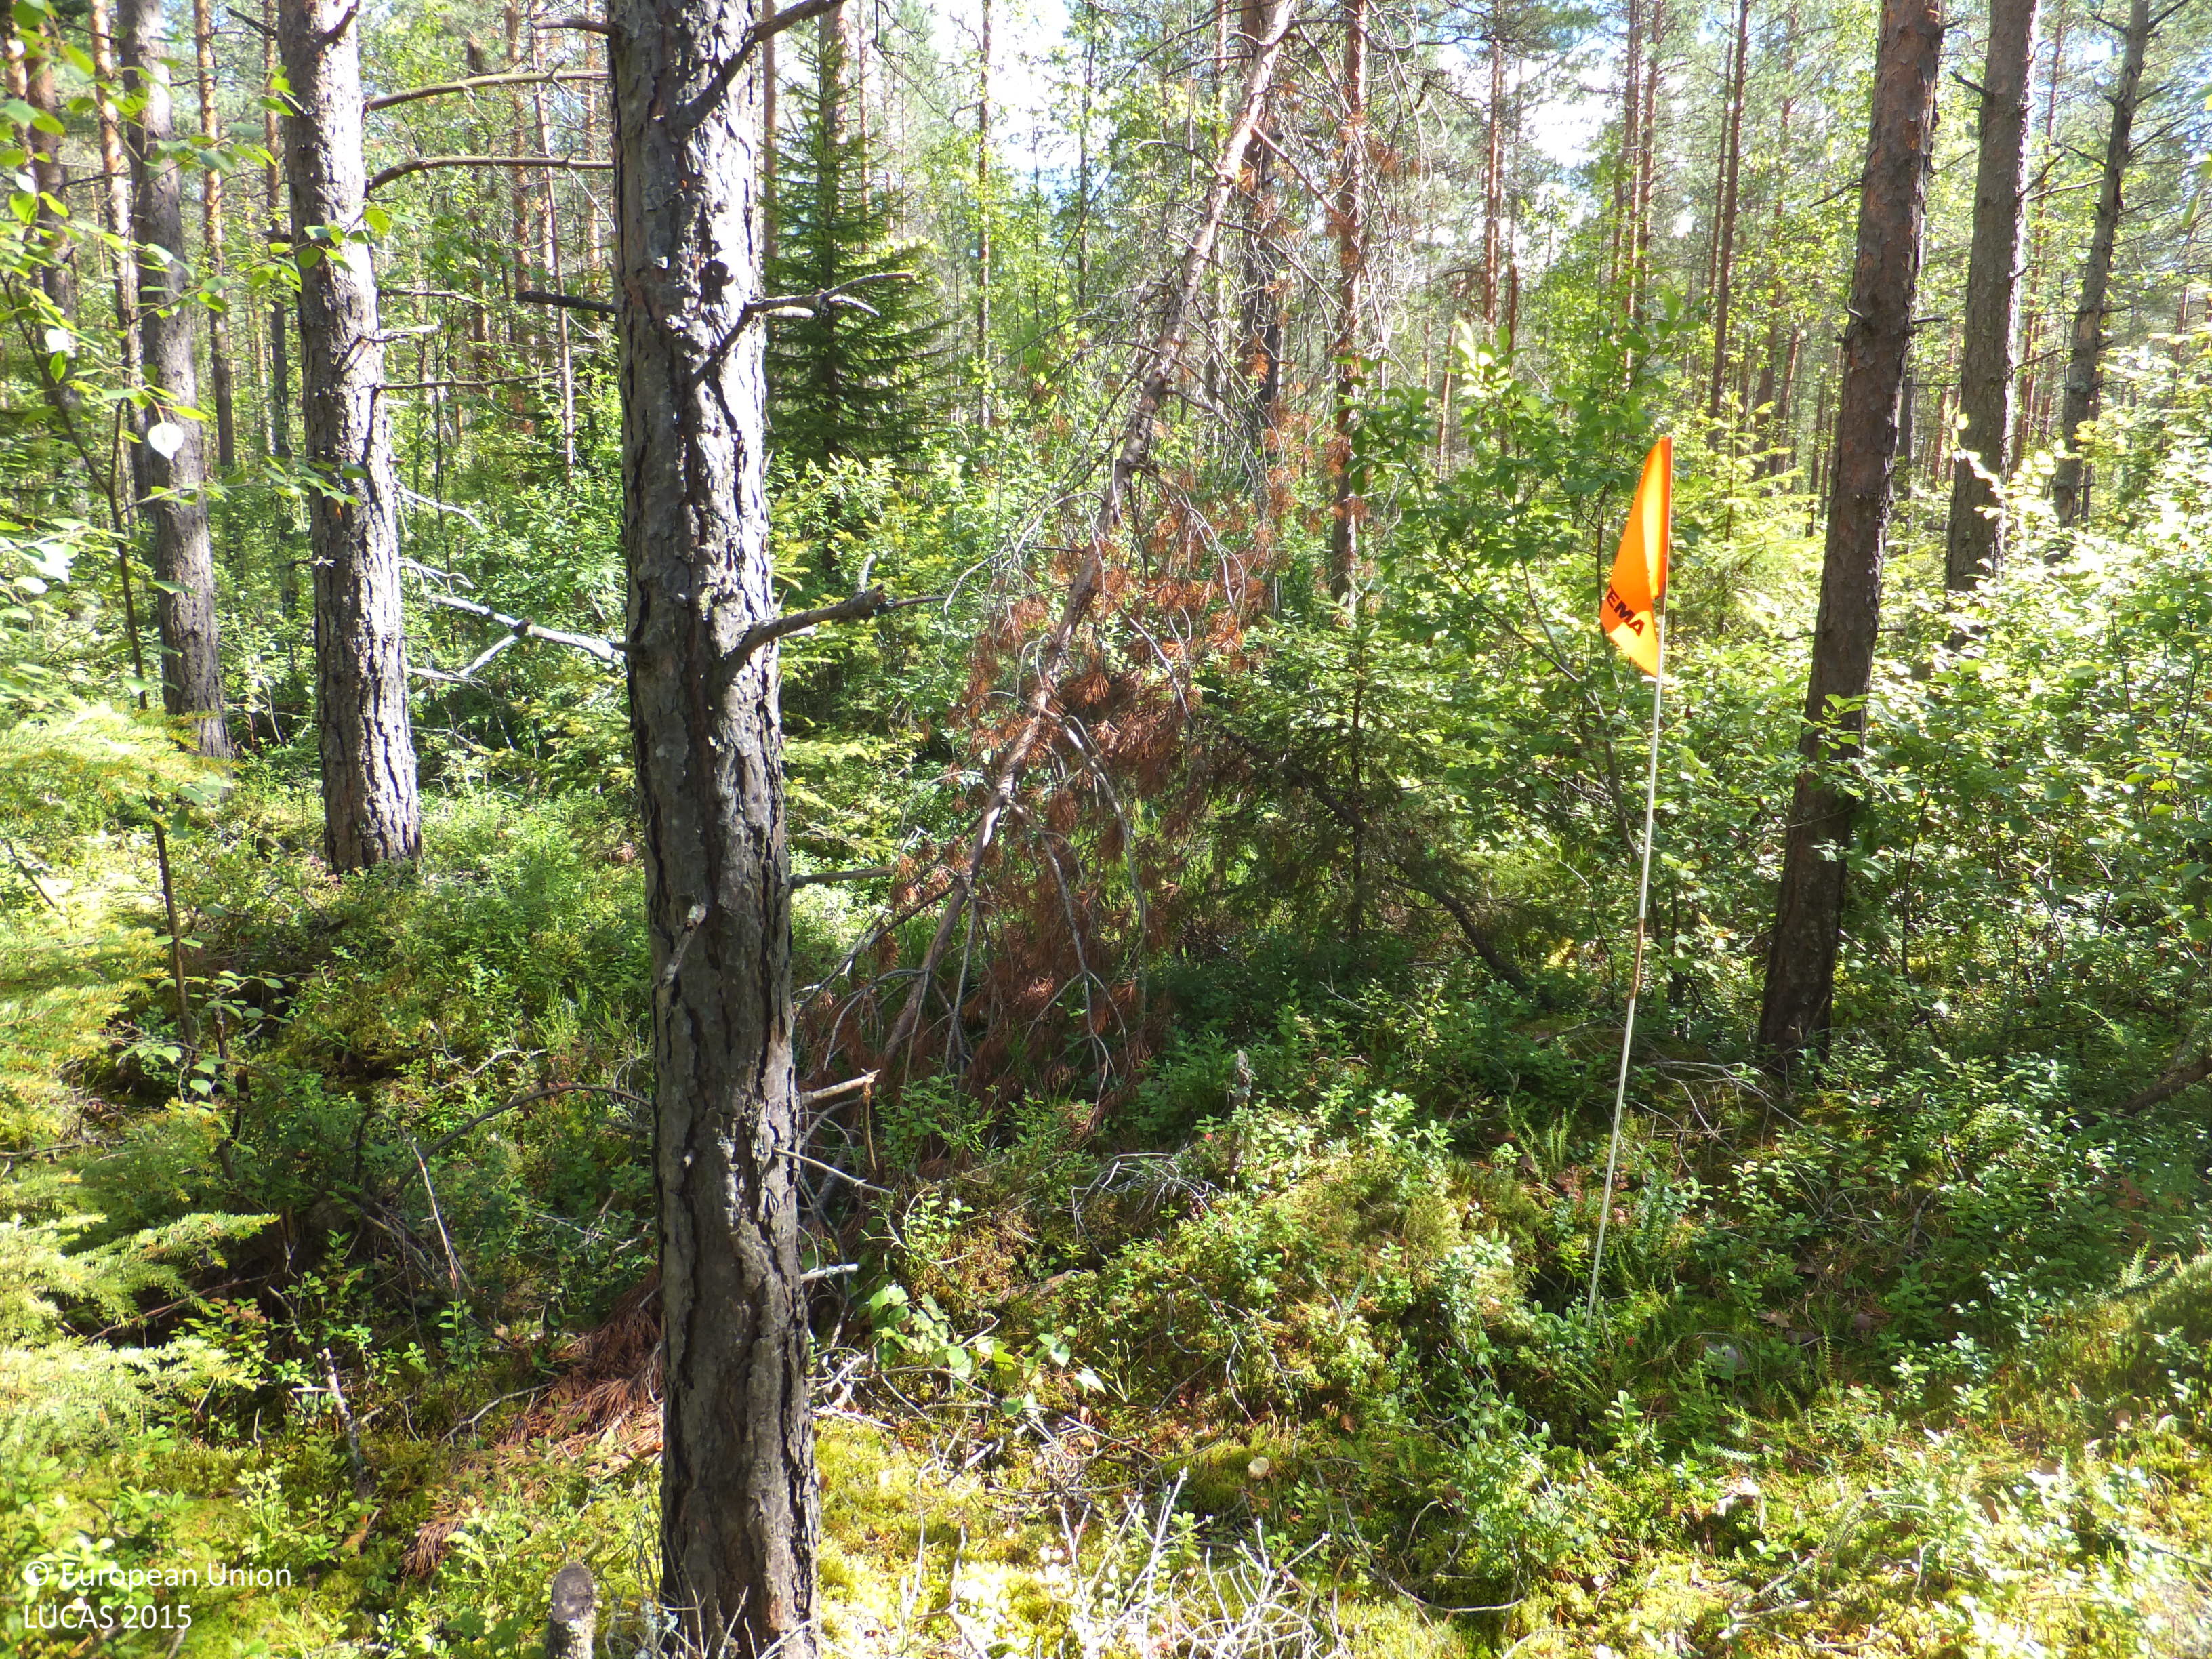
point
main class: Woodland
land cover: Pine dominated coniferous woodland
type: boreal forest
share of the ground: > 75 %
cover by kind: coniferous forest trees 75 %, shrubs 10 %, lichens and mosses 10 %, broadleaved forest trees 5 %
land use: Forestry
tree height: > 5 m
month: August
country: FI
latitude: 63.2645
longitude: 23.1082
